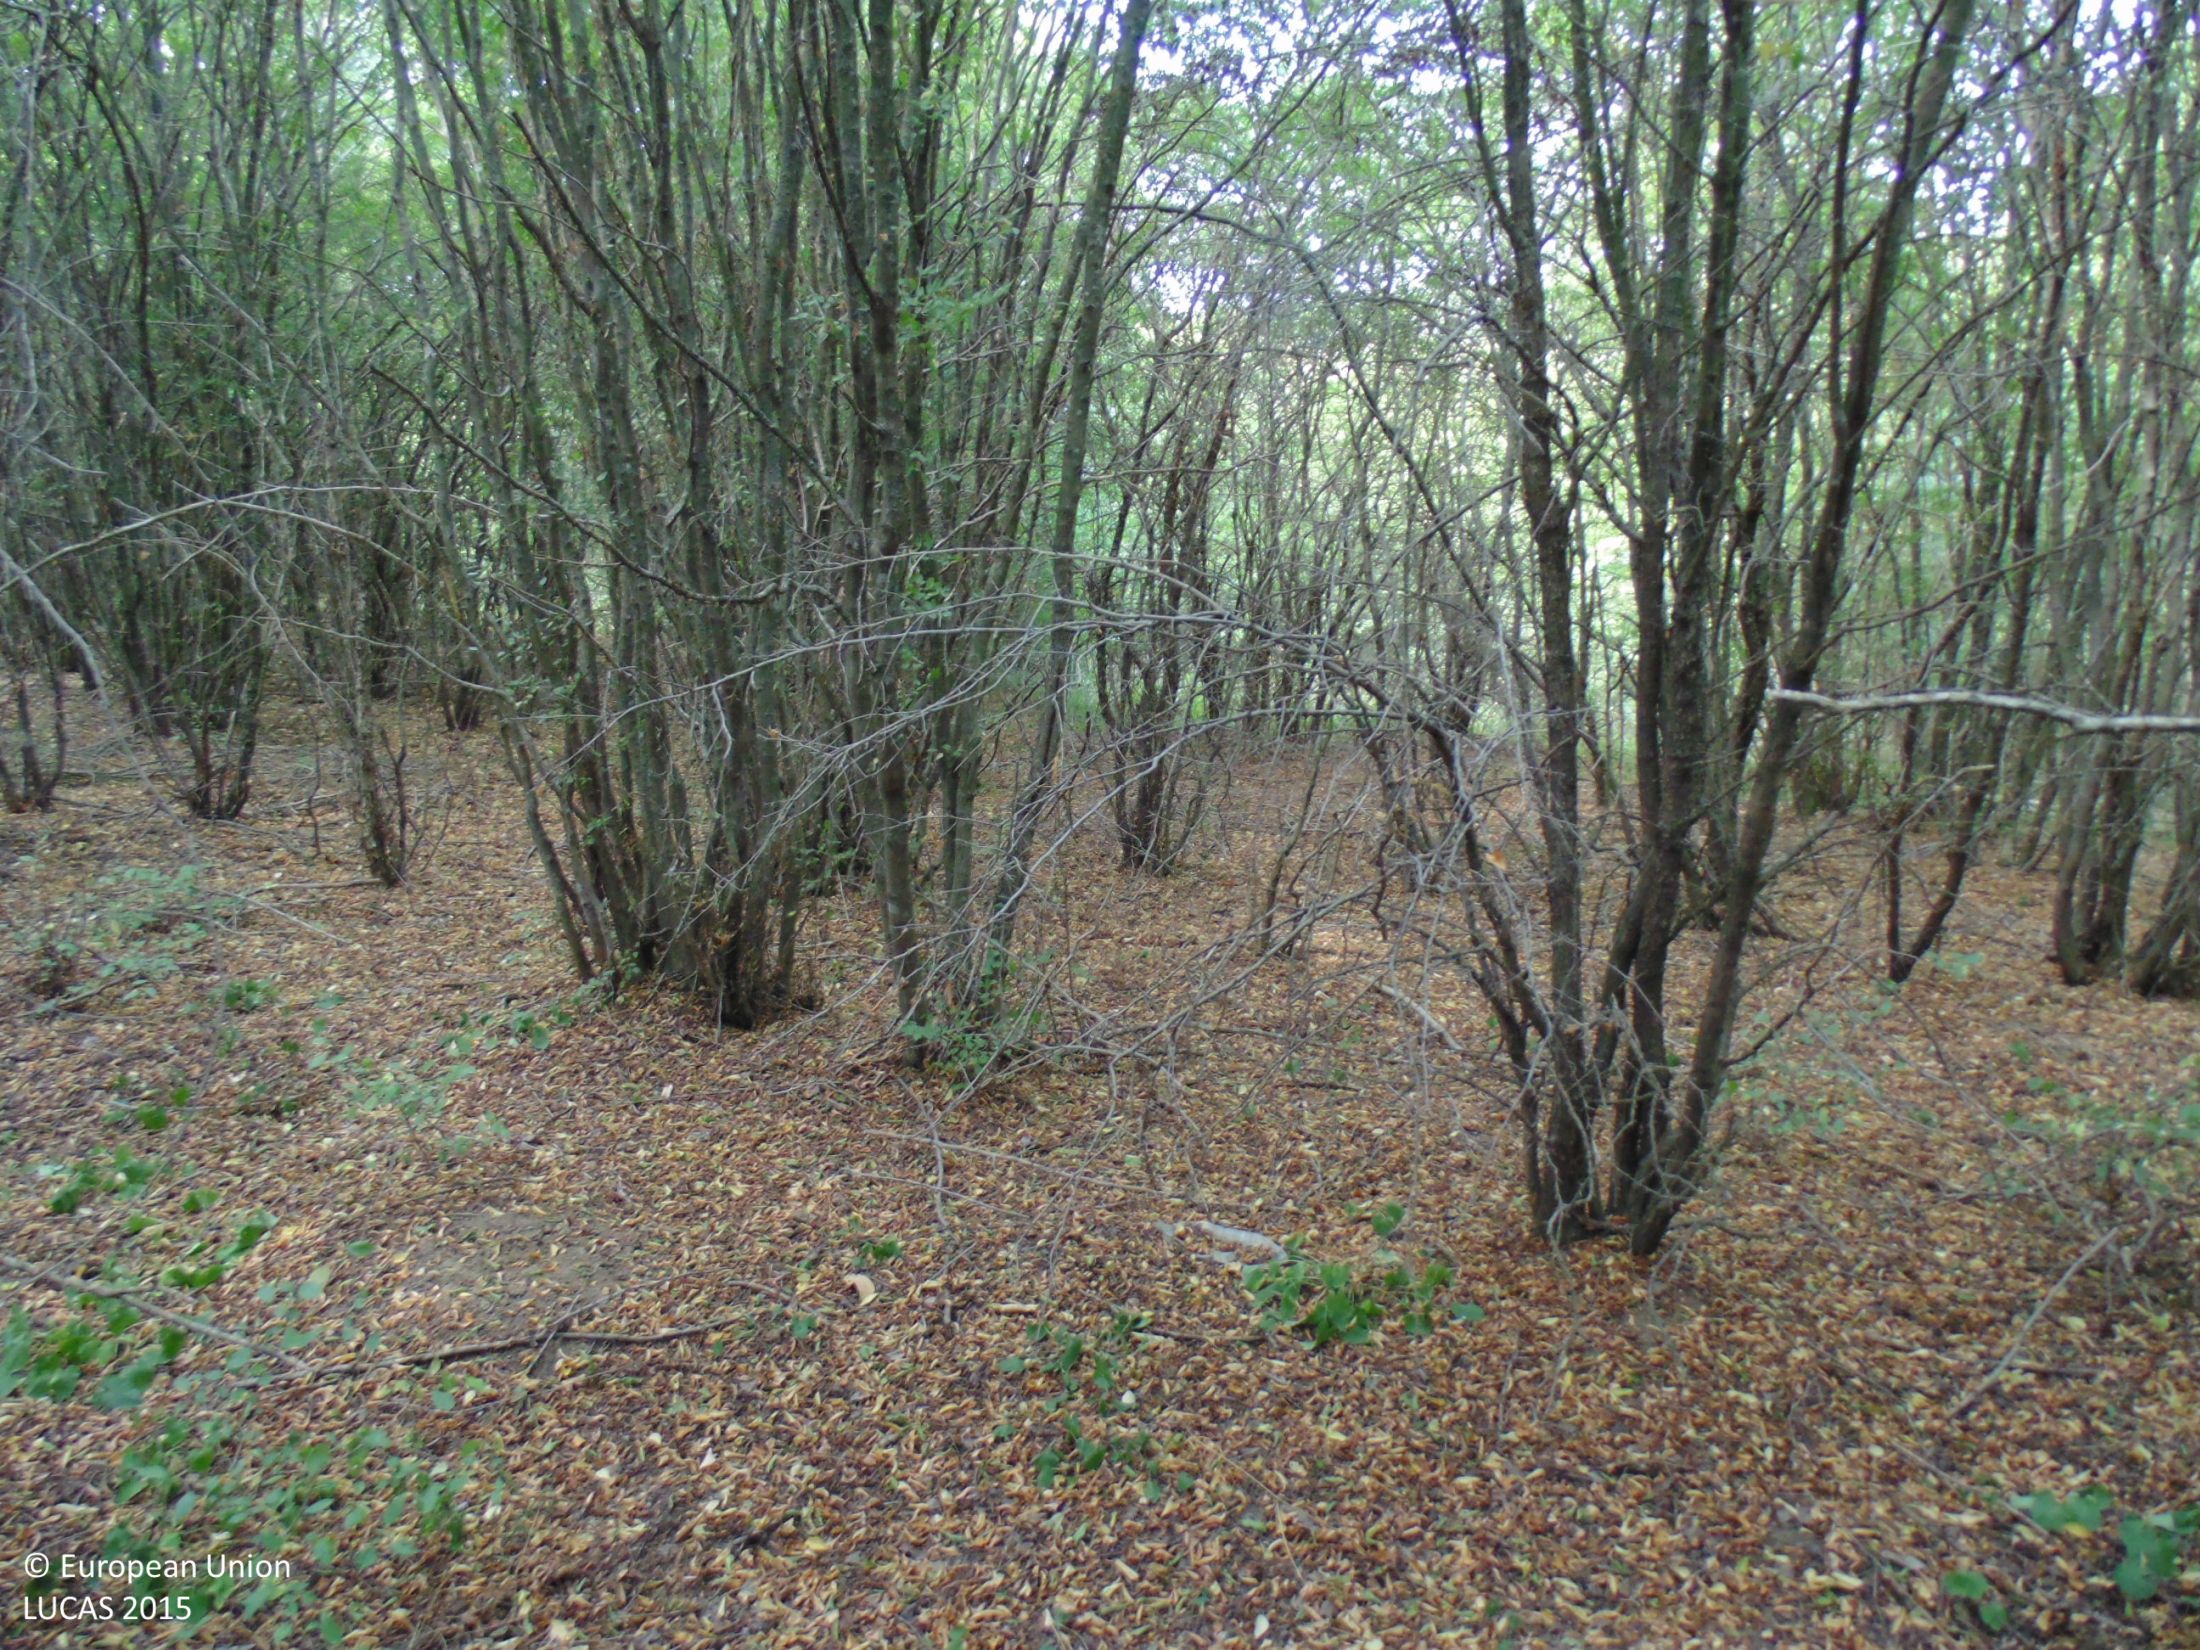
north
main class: Woodland
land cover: Broadleaved woodland
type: mesophytic deciduous forest
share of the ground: > 75 %
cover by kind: broadleaved forest trees 95 %, unconsolidated bare surface 5 %
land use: Forestry
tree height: > 5 m
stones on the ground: < 10 %
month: August
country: BG
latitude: 43.9127
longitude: 27.6359
